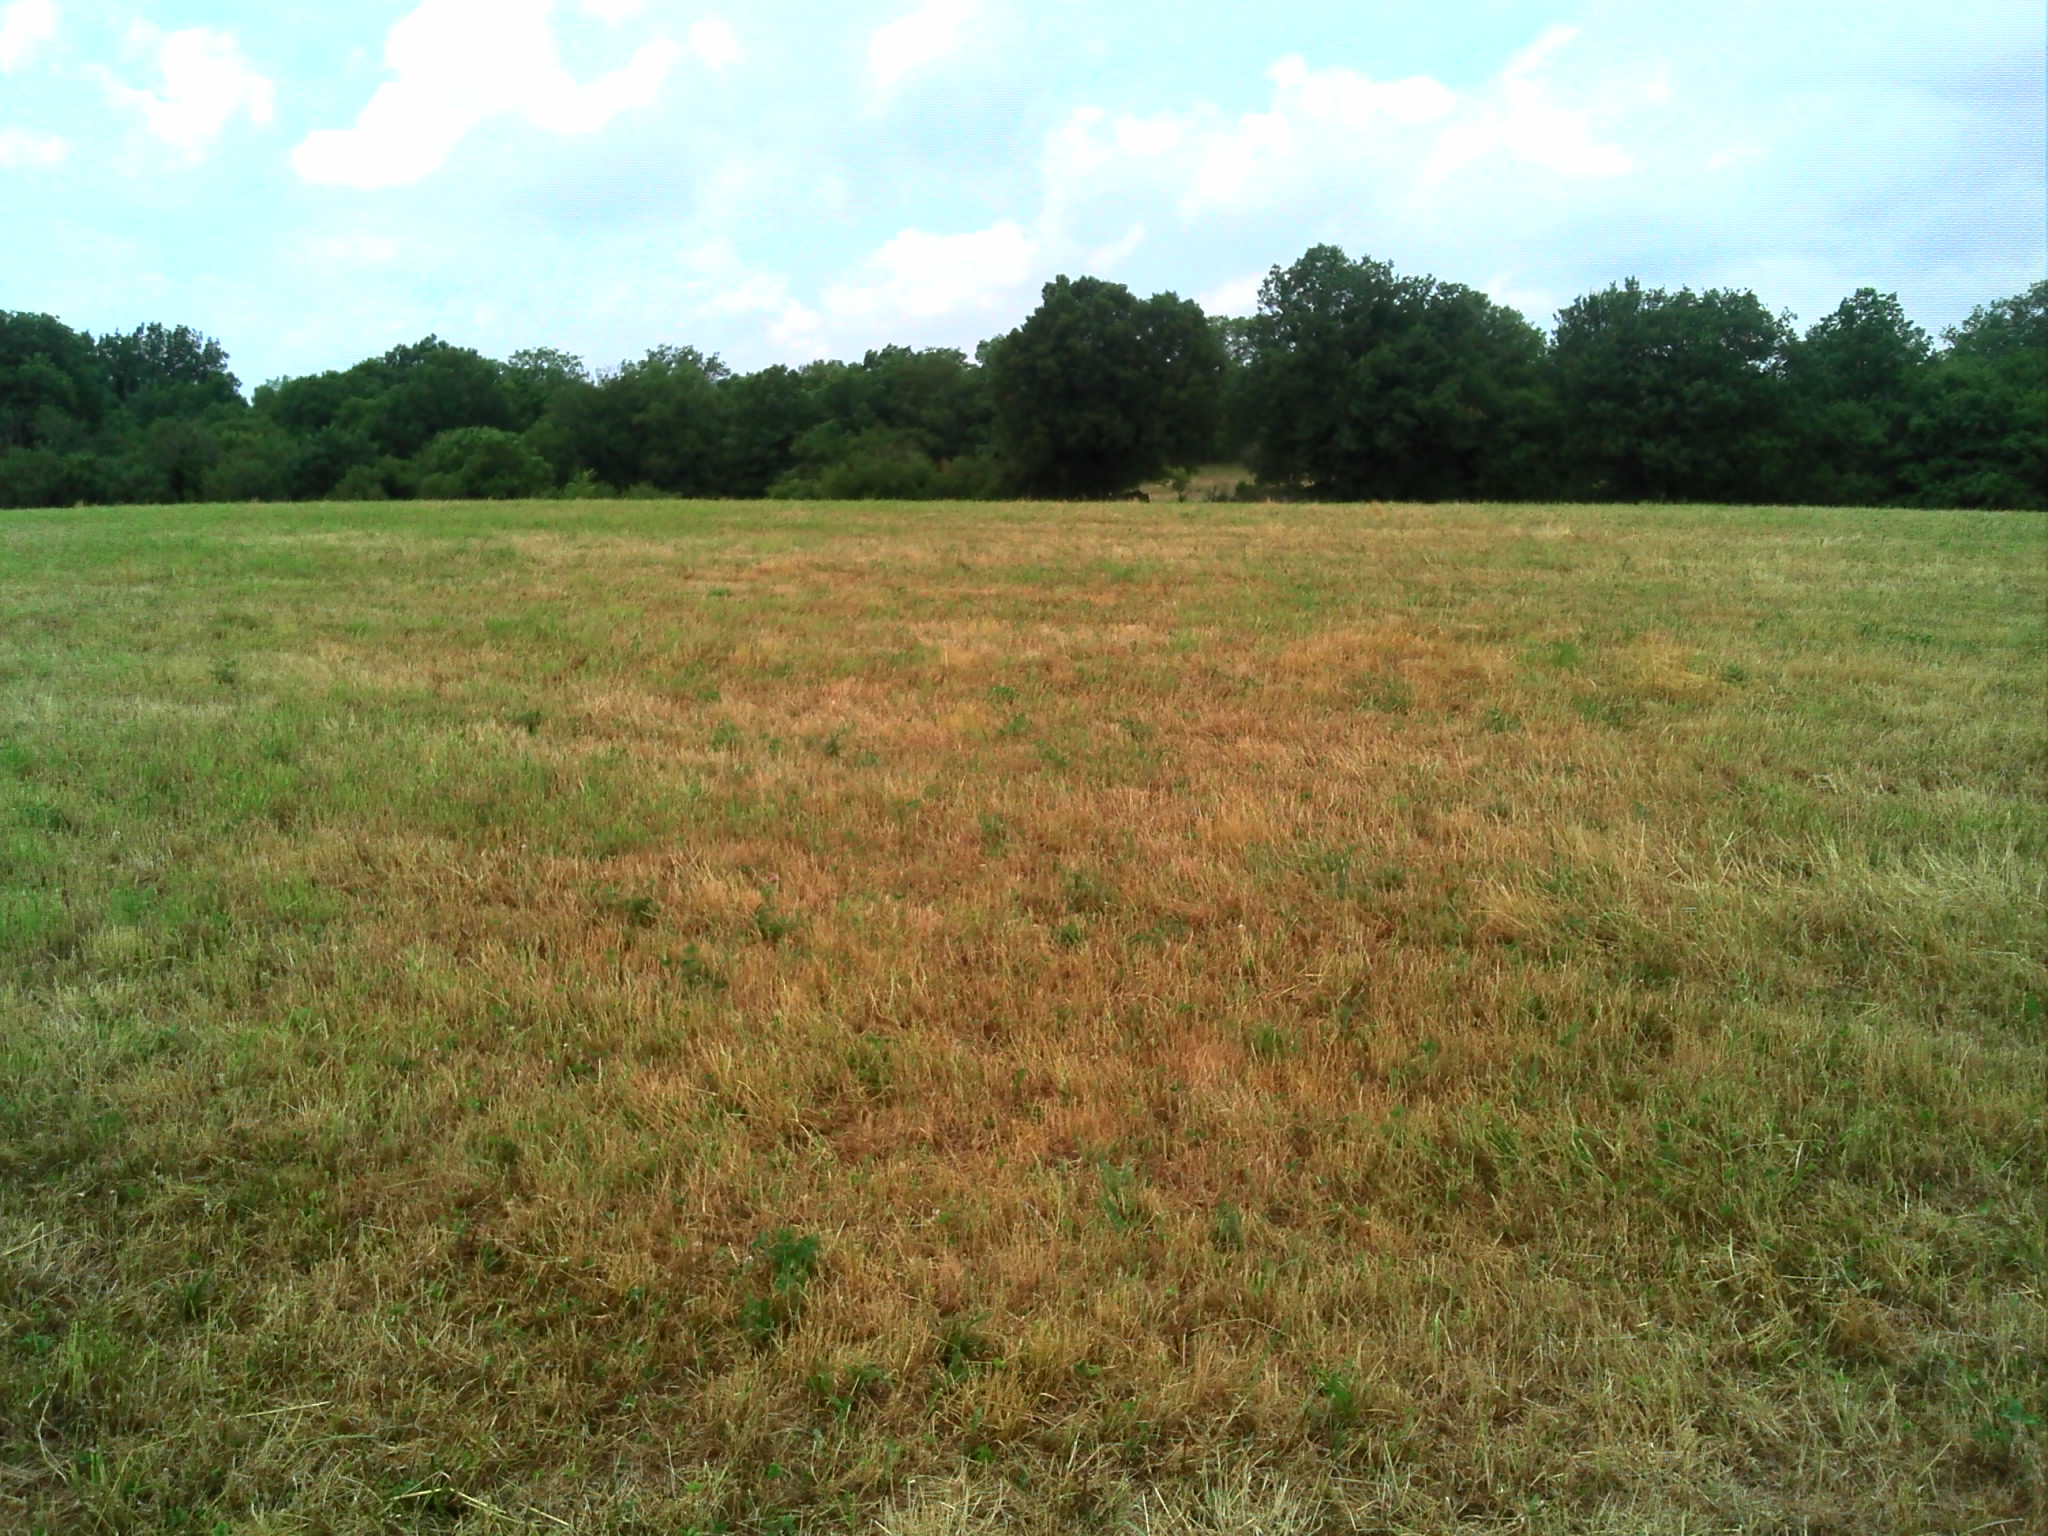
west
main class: Grassland
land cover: Grassland without tree/shrub cover
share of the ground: > 75 %
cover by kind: herbaceous plants 100 %
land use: Agriculture (excluding fallow land and kitchen gardens)
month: June
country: FR
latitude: 44.6967
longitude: 1.8088
